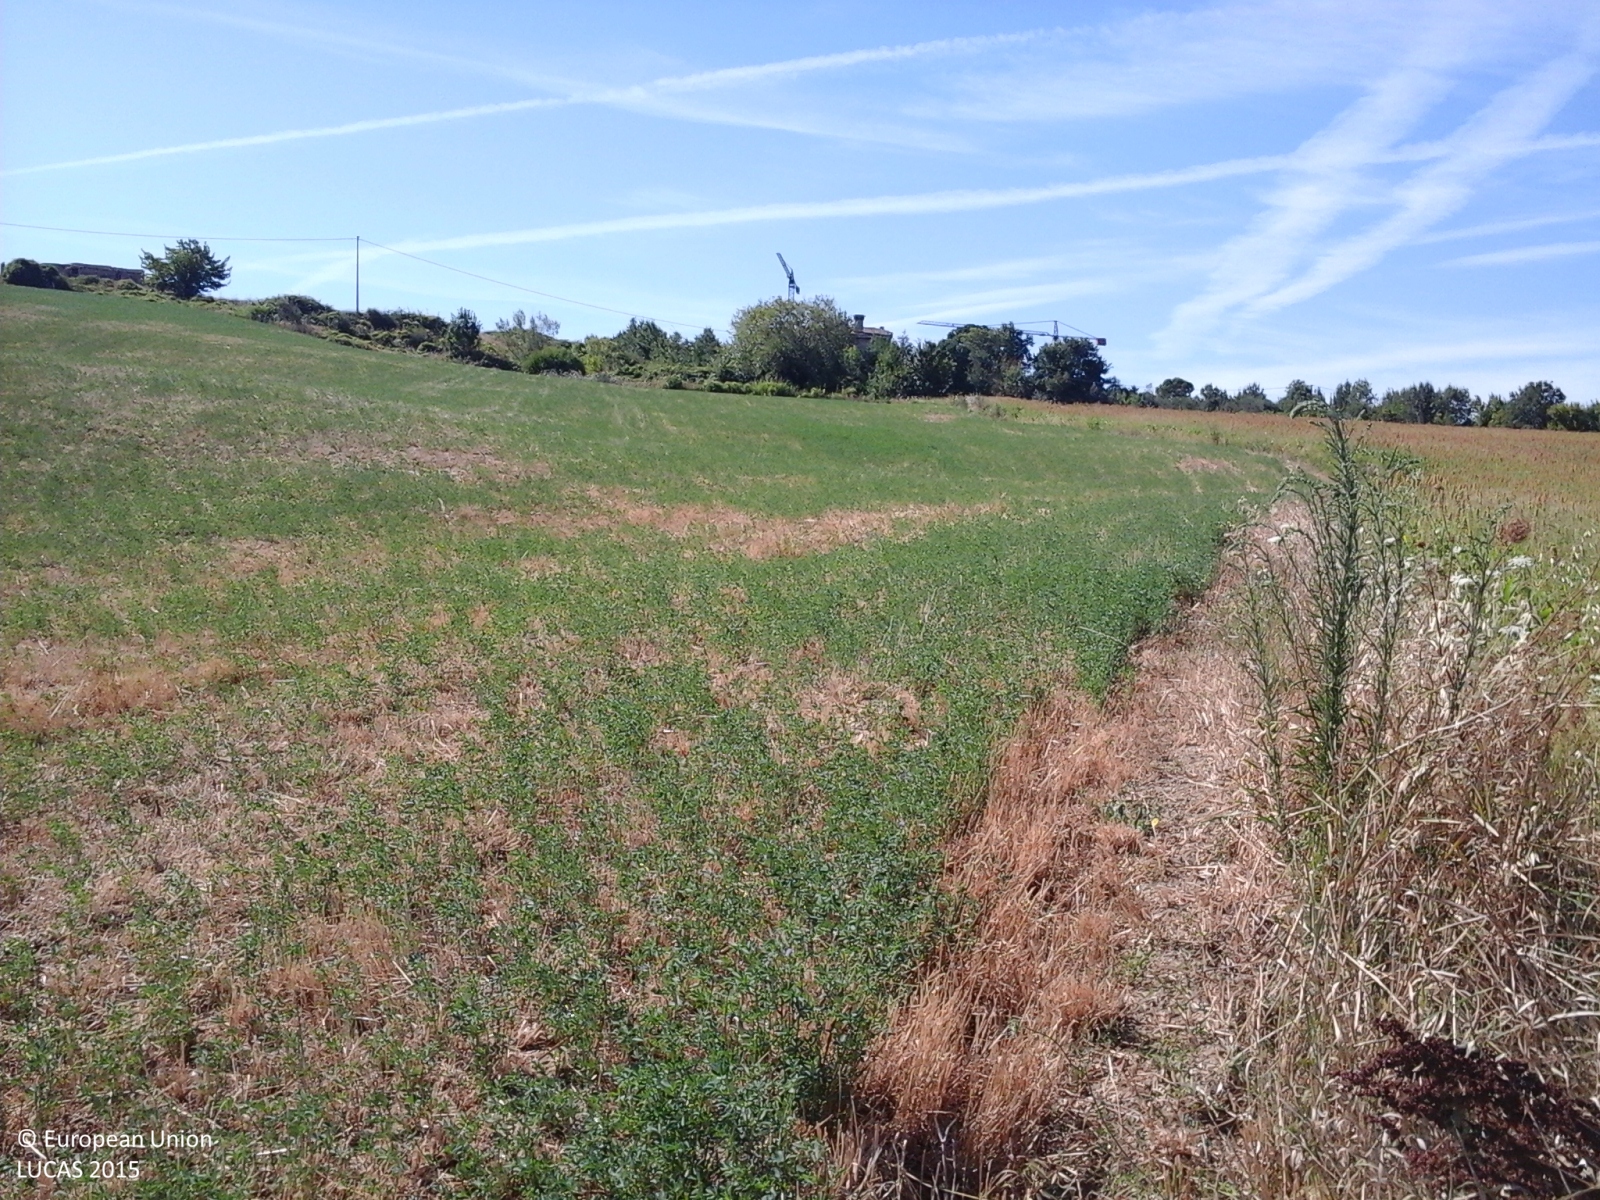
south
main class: Cropland
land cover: Other cereals
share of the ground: > 75 %
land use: Agriculture (excluding fallow land and kitchen gardens)
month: July
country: IT
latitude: 43.9011
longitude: 12.6705
